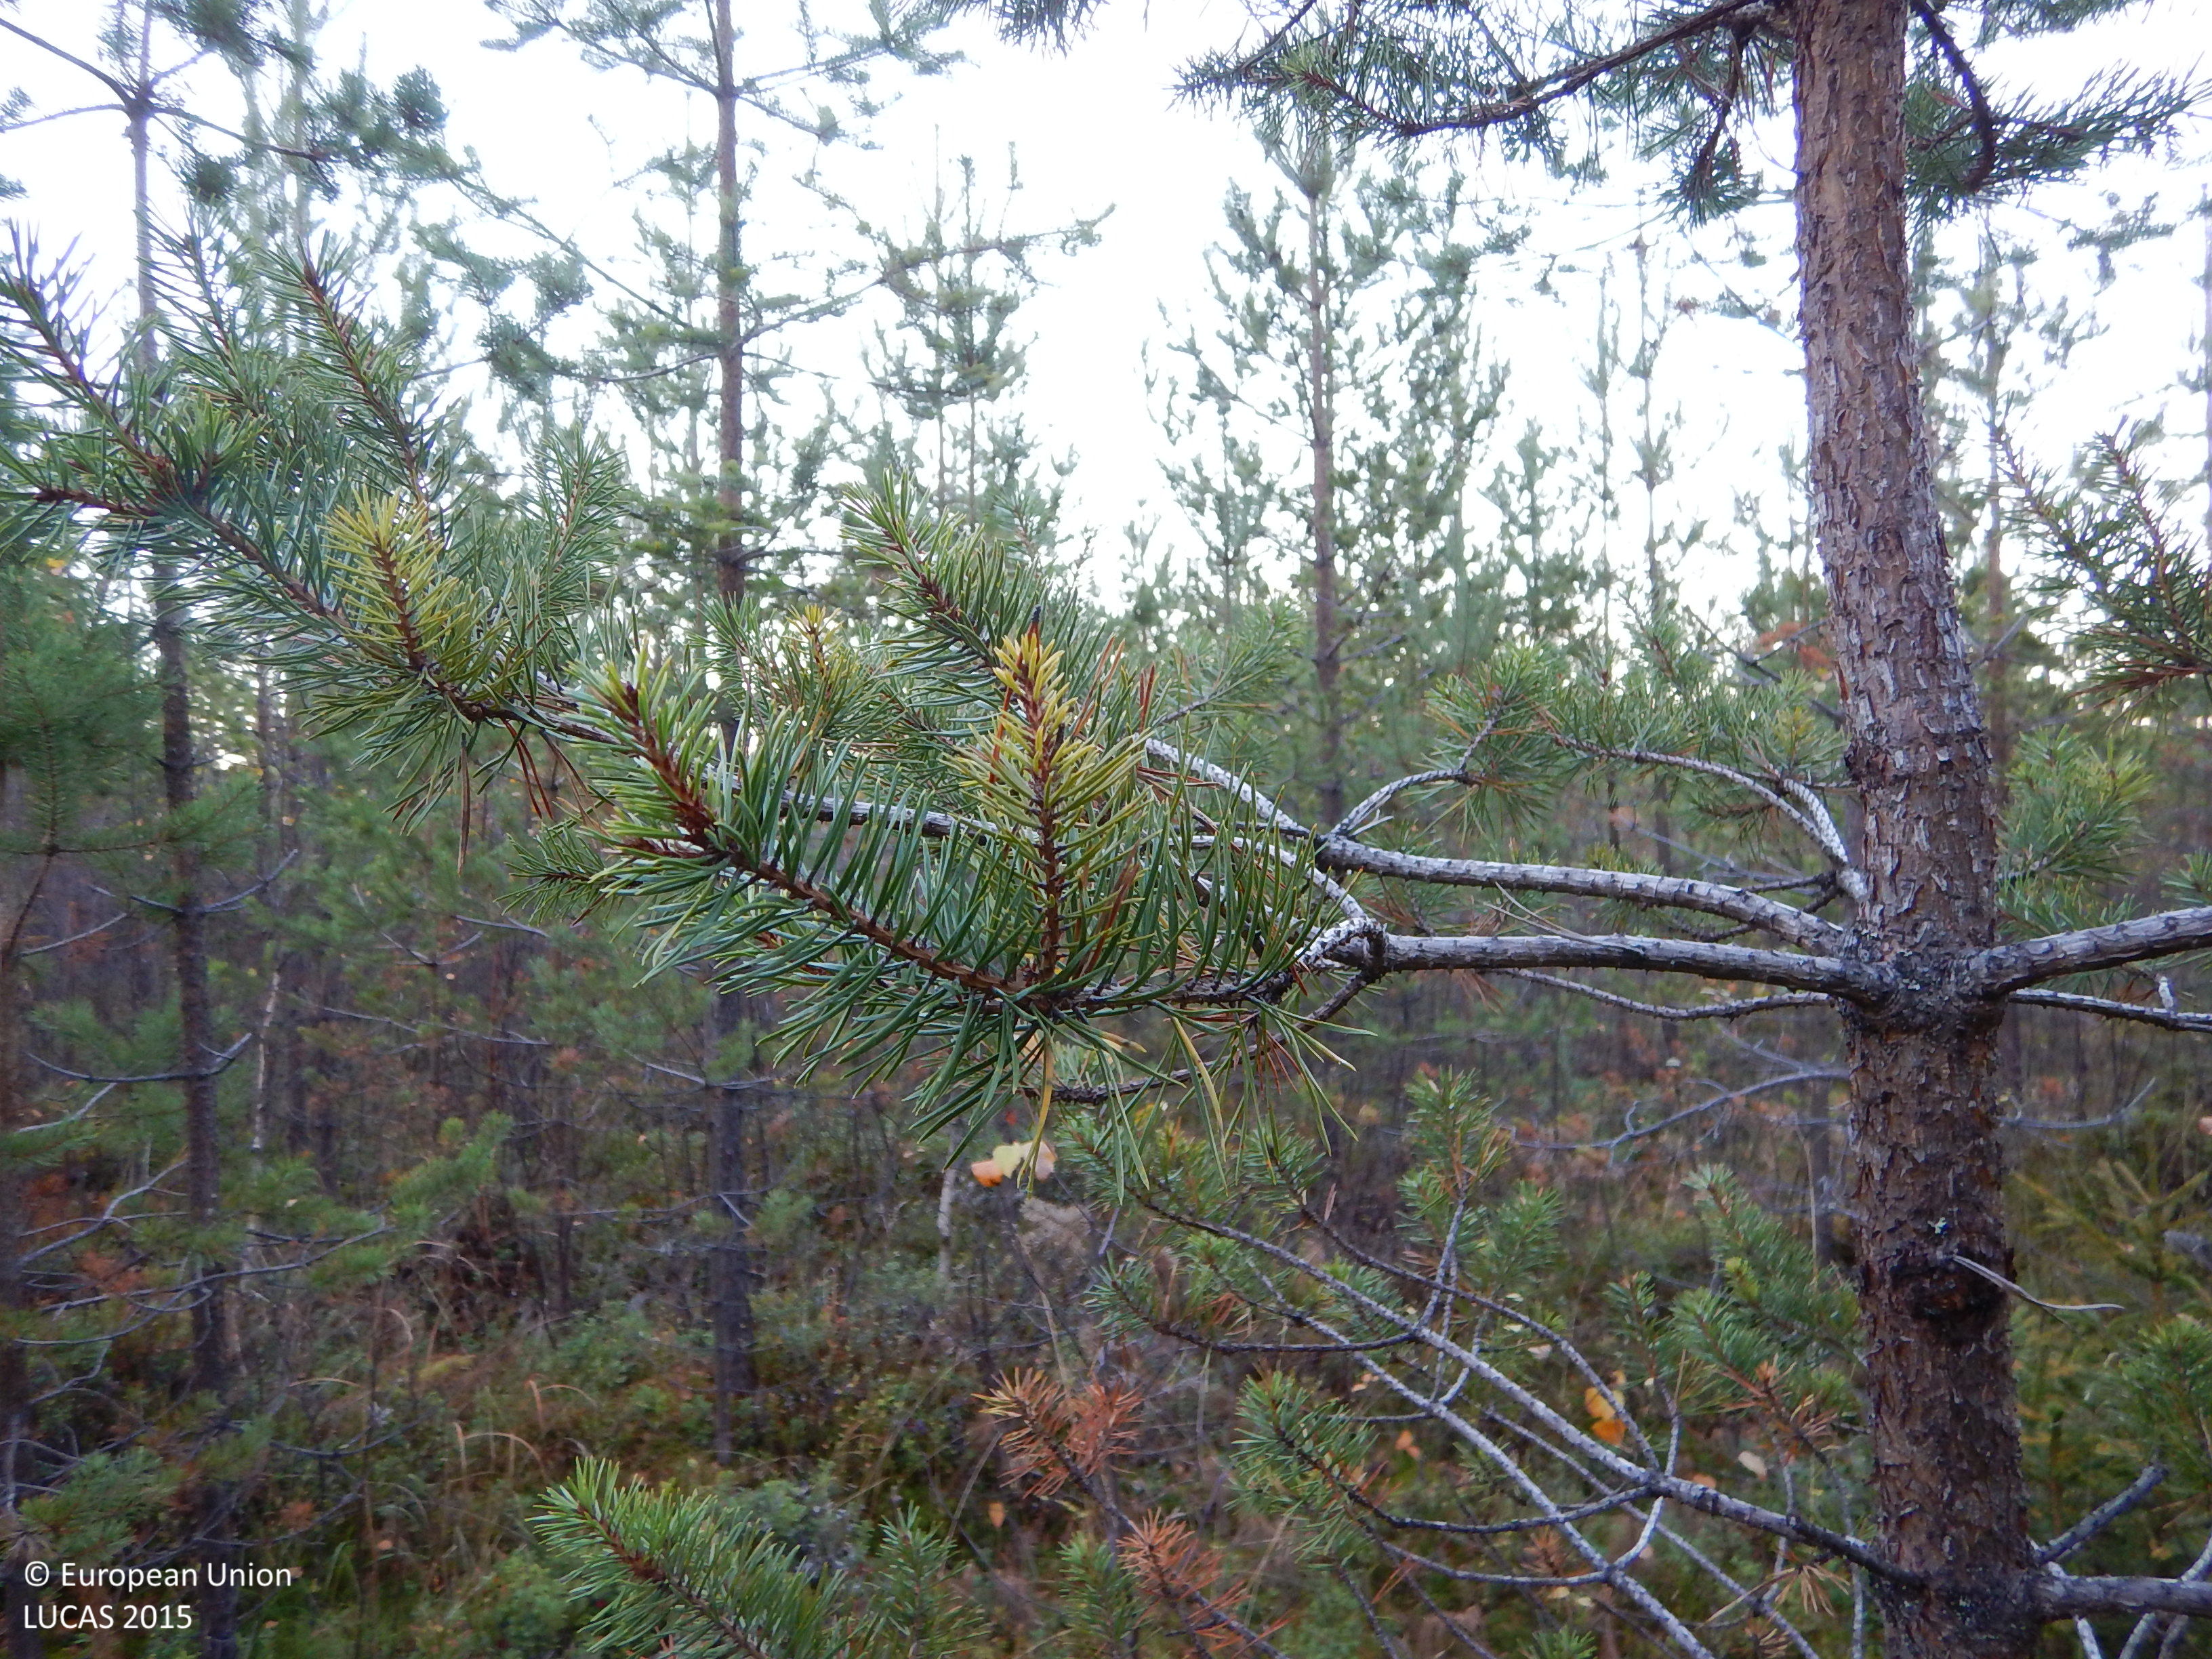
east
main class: Woodland
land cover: Pine dominated mixed woodland
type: boreal forest
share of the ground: 50 - 75 %
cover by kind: coniferous forest trees 50 %, broadleaved forest trees 20 %, shrubs 10 %, herbaceous plants 10 %, lichens and mosses 10 %
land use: Forestry
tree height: < 5 m
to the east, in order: Pine dominated mixed woodland; Rivers and streams; Pine dominated mixed woodland; Rivers and streams; Spruce dominated mixed woodland; Other mixed woodland
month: October
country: SE
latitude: 64.9466
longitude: 21.0030
